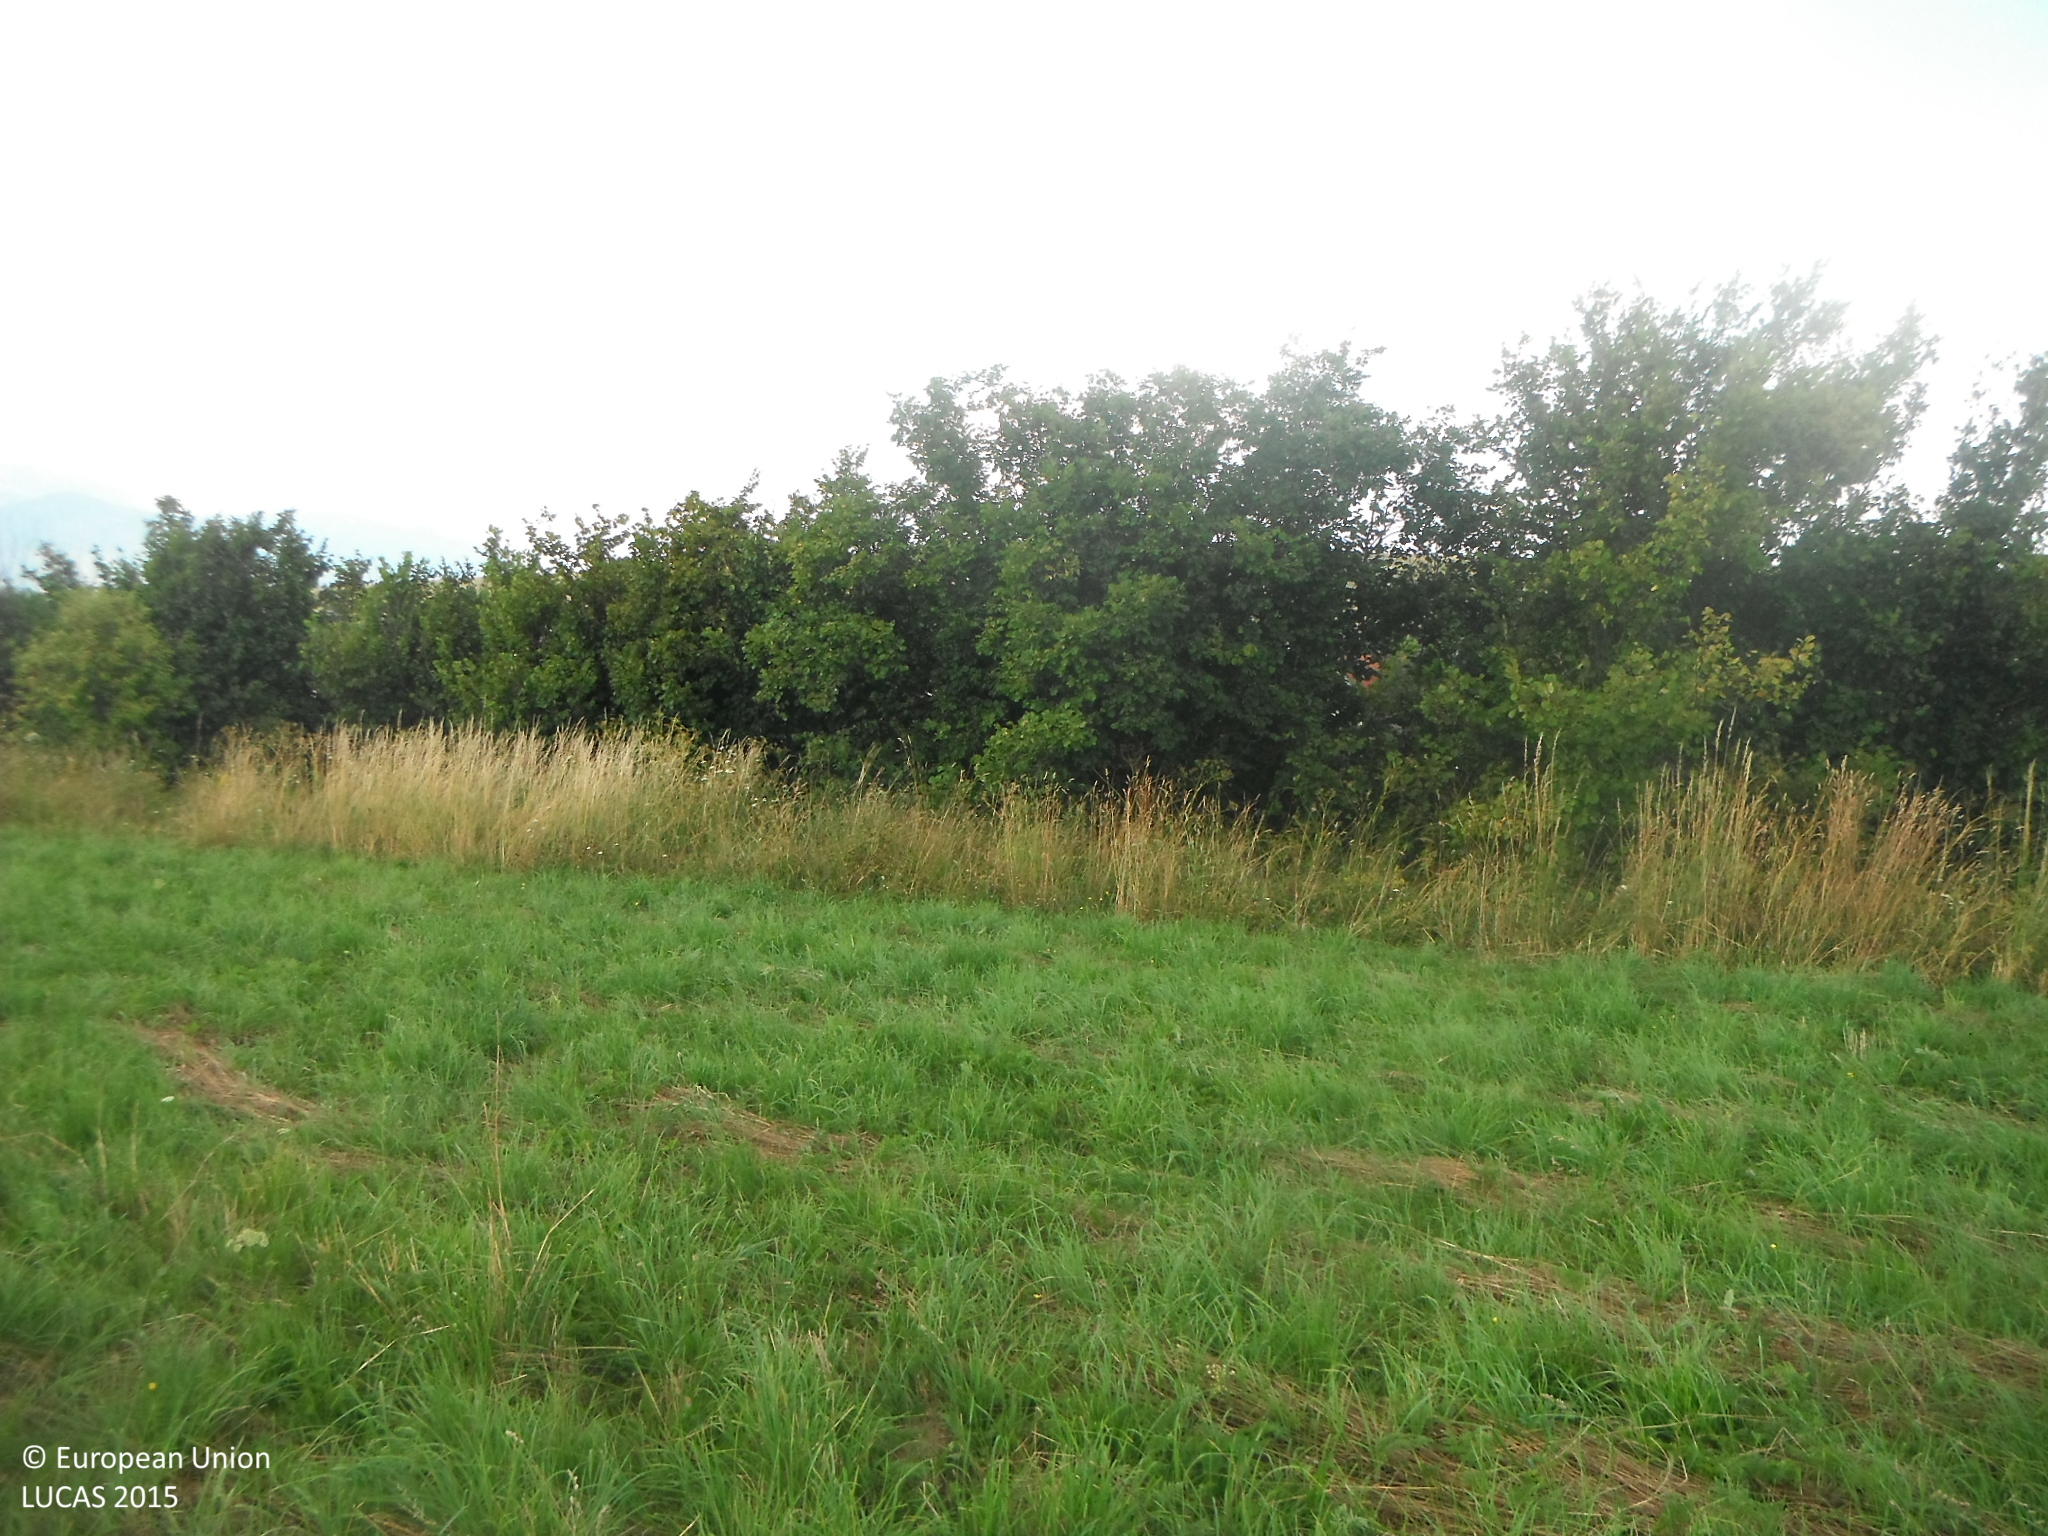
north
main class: Grassland
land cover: Grassland without tree/shrub cover
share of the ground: > 75 %
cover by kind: herbaceous plants 100 %
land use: Agriculture (excluding fallow land and kitchen gardens)
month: July
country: SK
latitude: 49.1362
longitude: 20.3002
